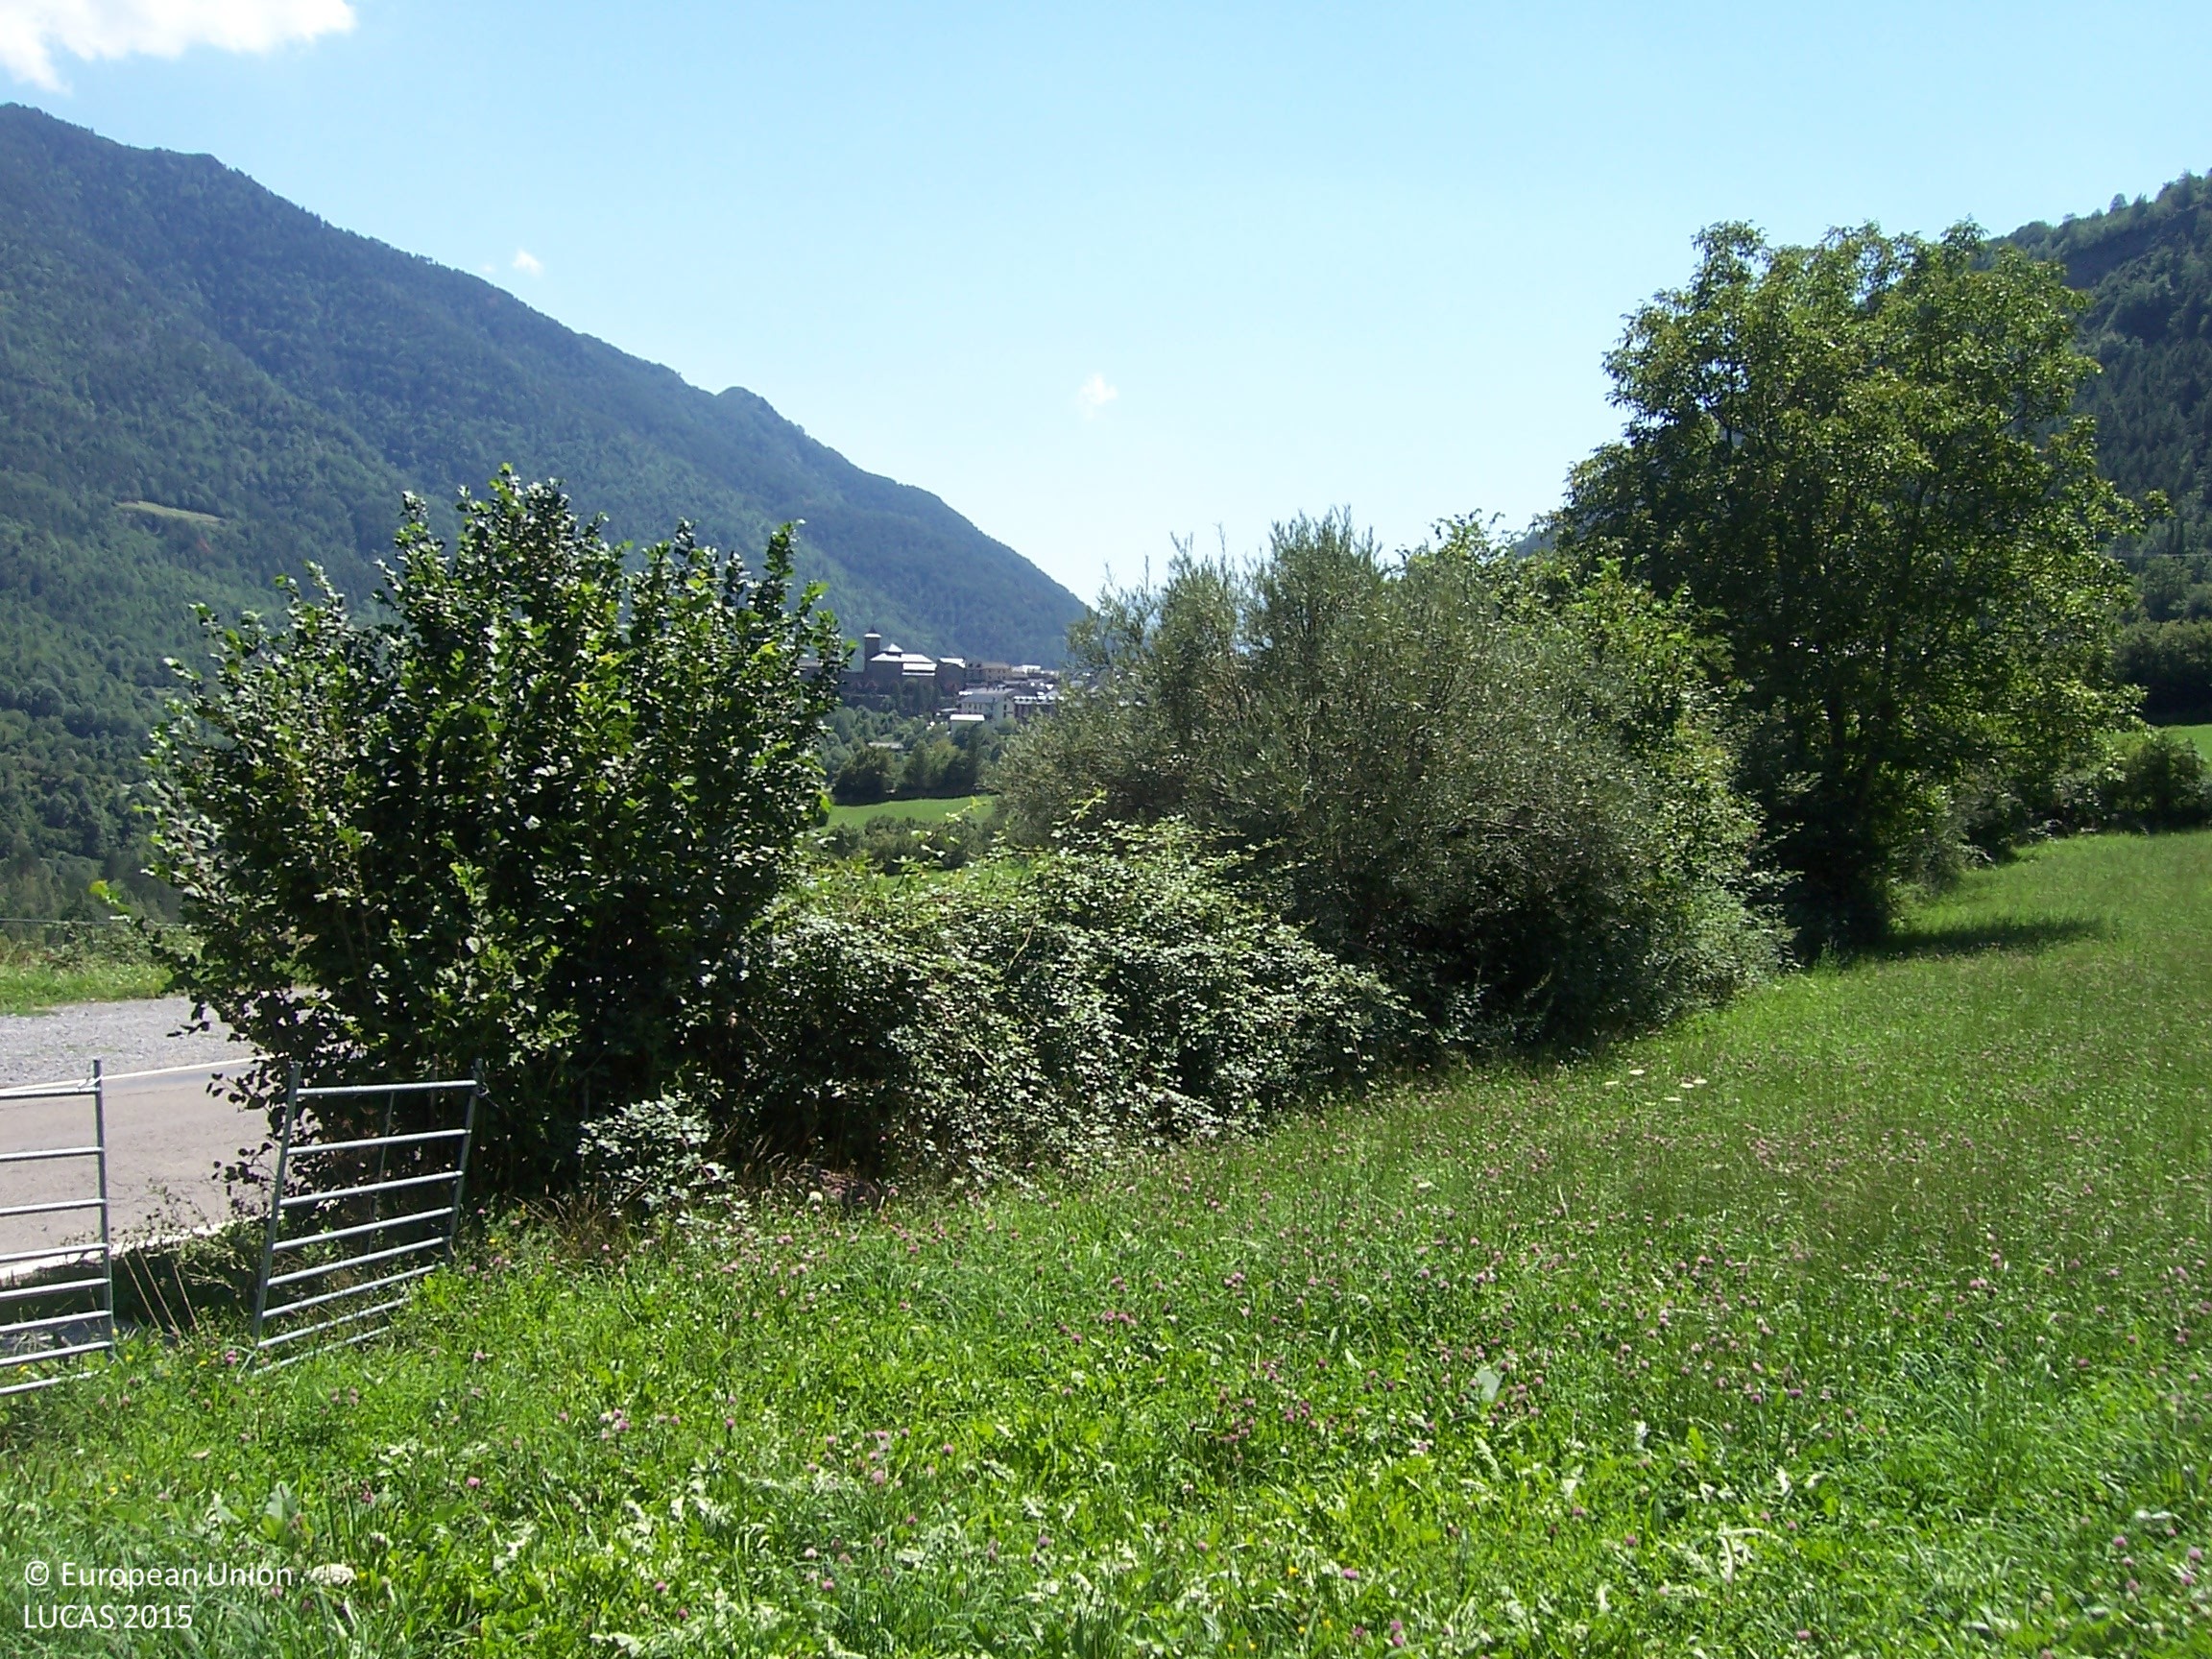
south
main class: Woodland
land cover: Pine dominated coniferous woodland
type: coniferous forest of the mediterranean region
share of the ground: > 75 %
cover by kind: coniferous forest trees 75 %, herbaceous plants 15 %, shrubs 10 %
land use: Semi-natural and natural areas not in use
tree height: > 5 m
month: August
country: ES
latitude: 42.6403
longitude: -0.0859
